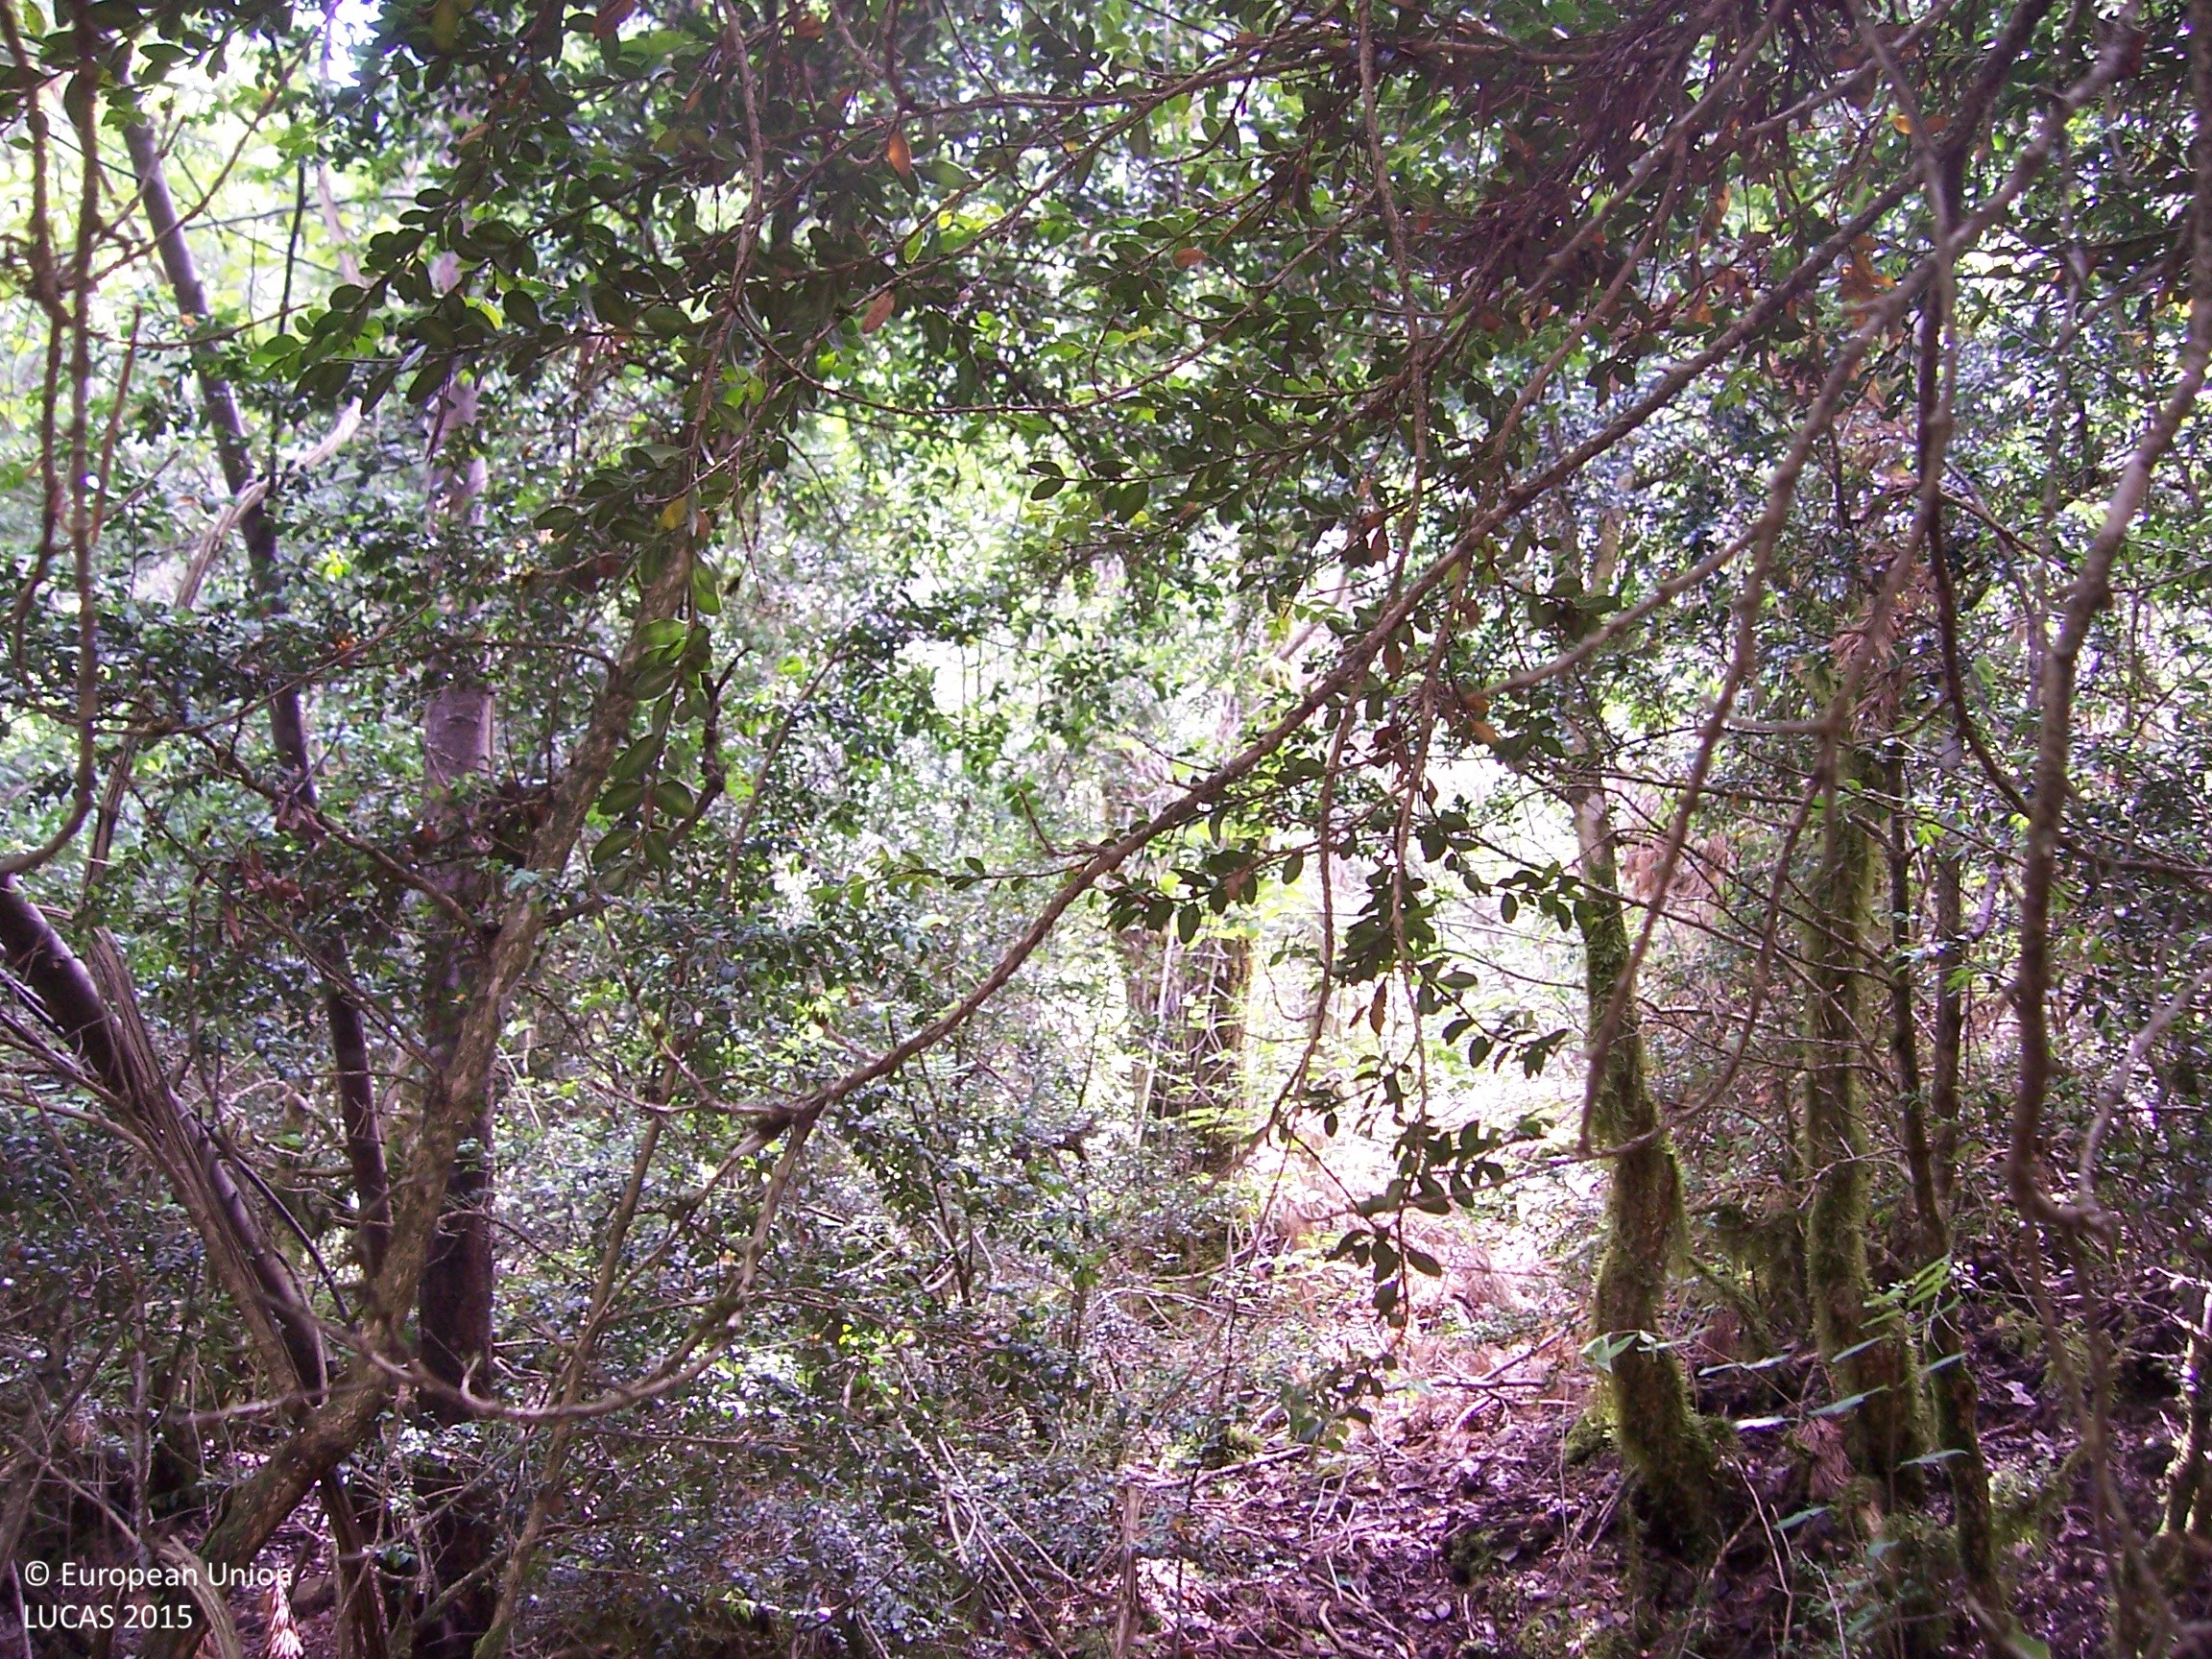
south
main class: Woodland
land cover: Pine dominated coniferous woodland
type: alpine coniferous forest
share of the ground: > 75 %
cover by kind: coniferous forest trees 100 %
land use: Forestry
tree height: > 5 m
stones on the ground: < 10 %
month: August
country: ES
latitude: 42.6134
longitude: -0.3514
